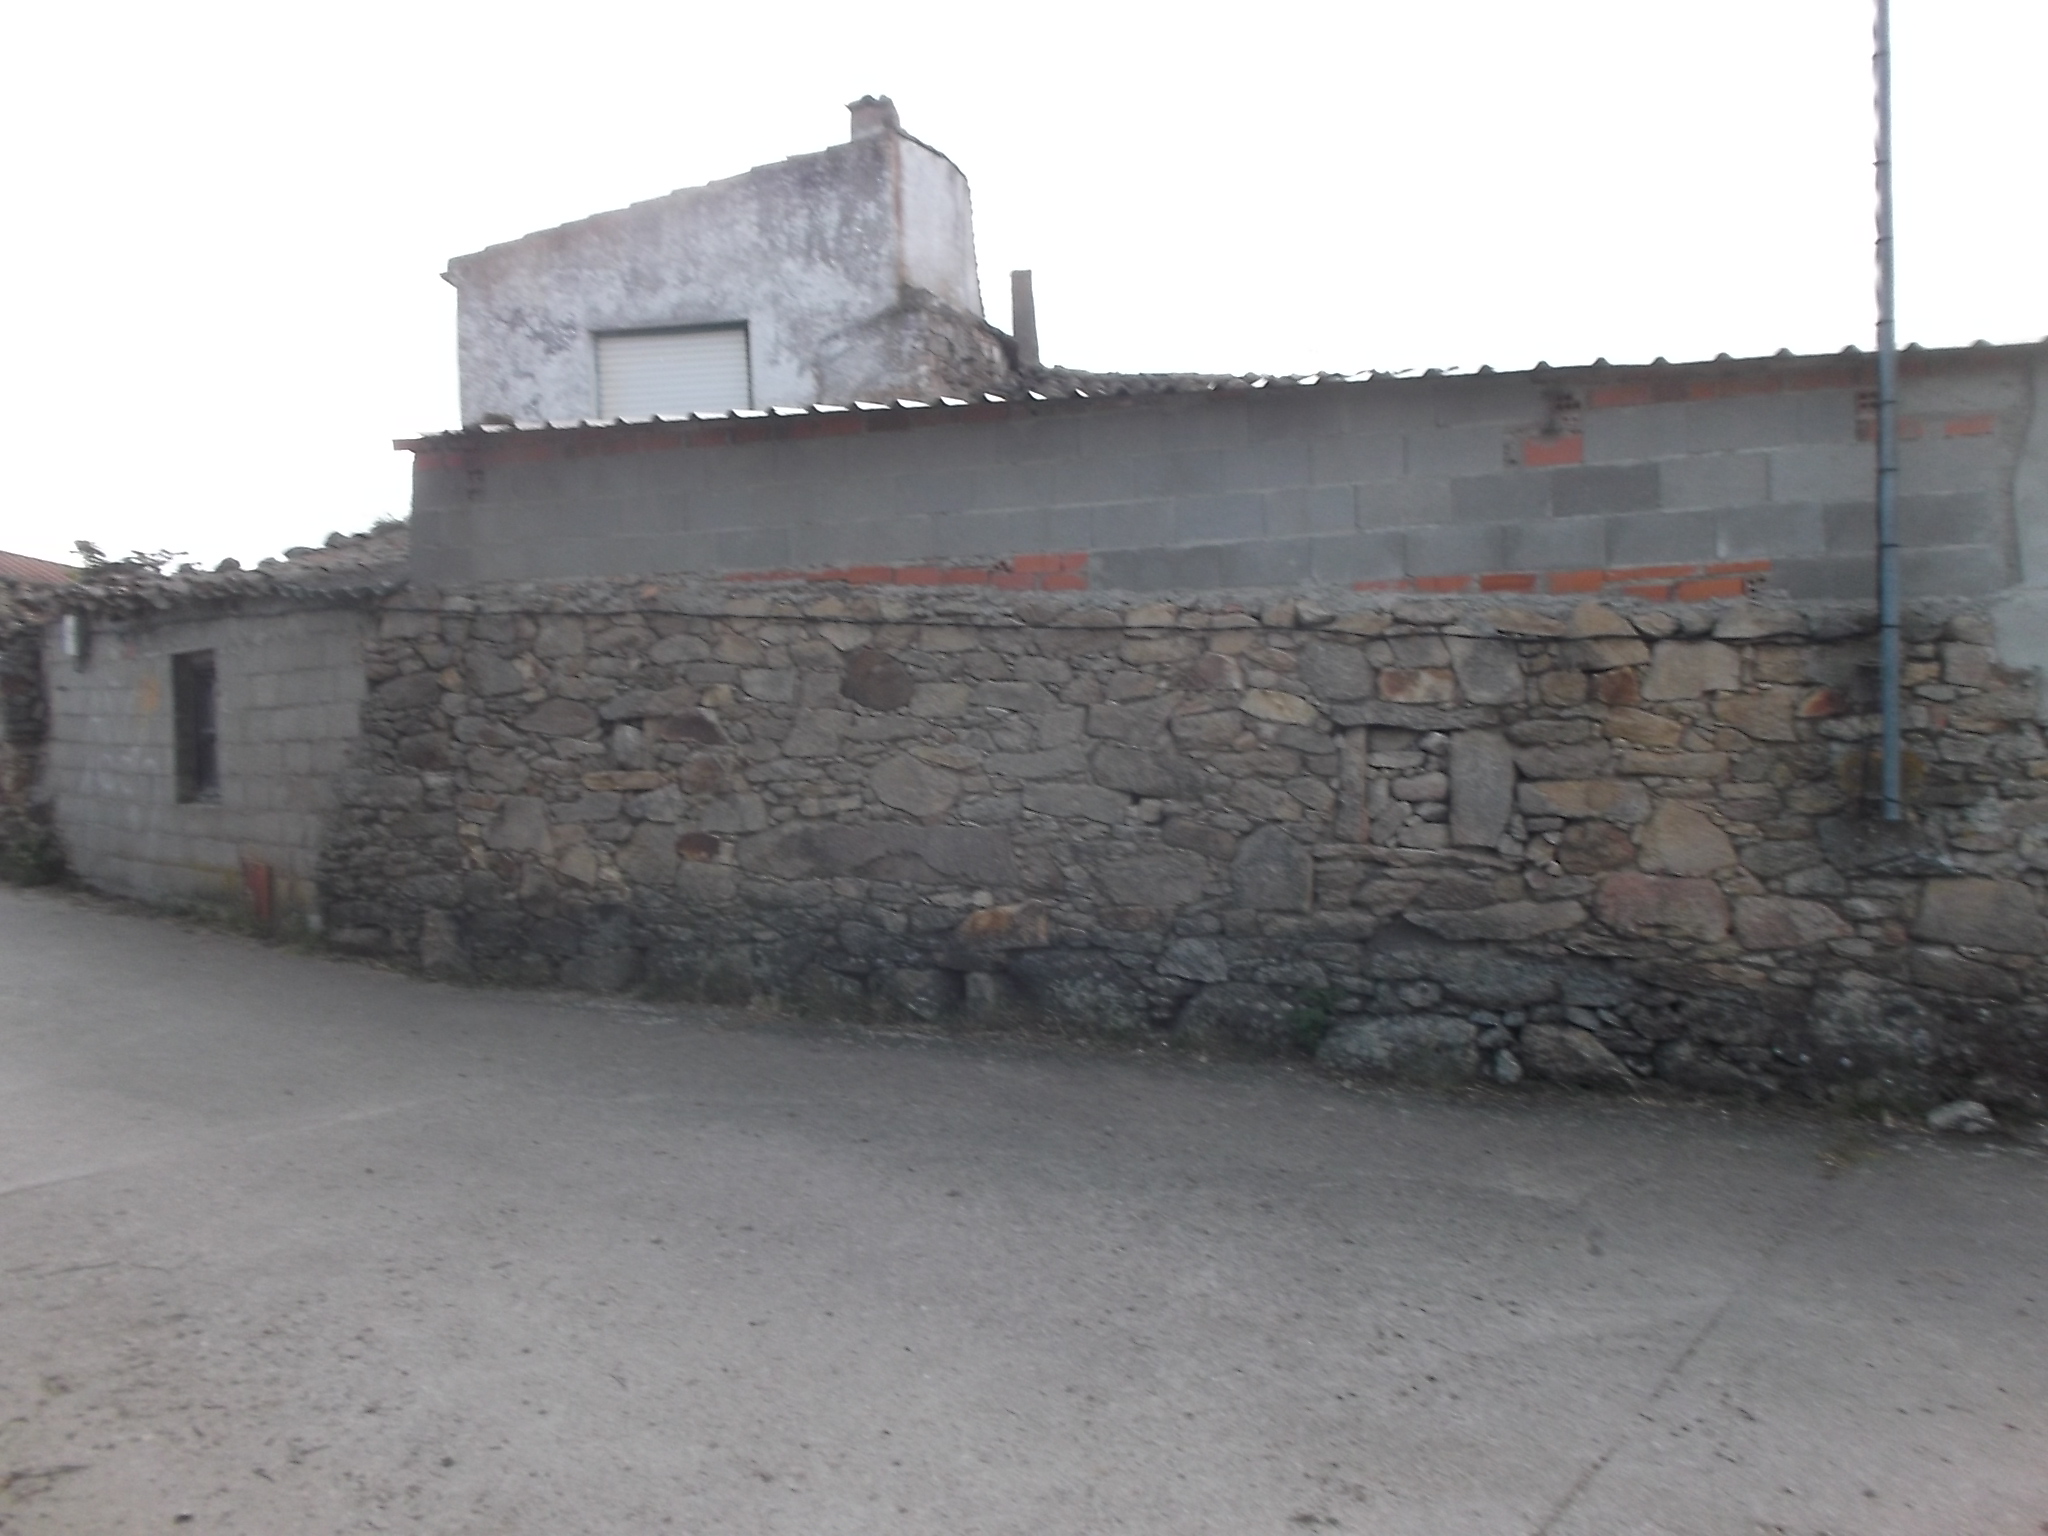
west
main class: Grassland
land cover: Grassland without tree/shrub cover
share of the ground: > 75 %
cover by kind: herbaceous plants 100 %
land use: Agriculture (excluding fallow land and kitchen gardens)
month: May
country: ES
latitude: 41.1127
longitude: -6.3491
